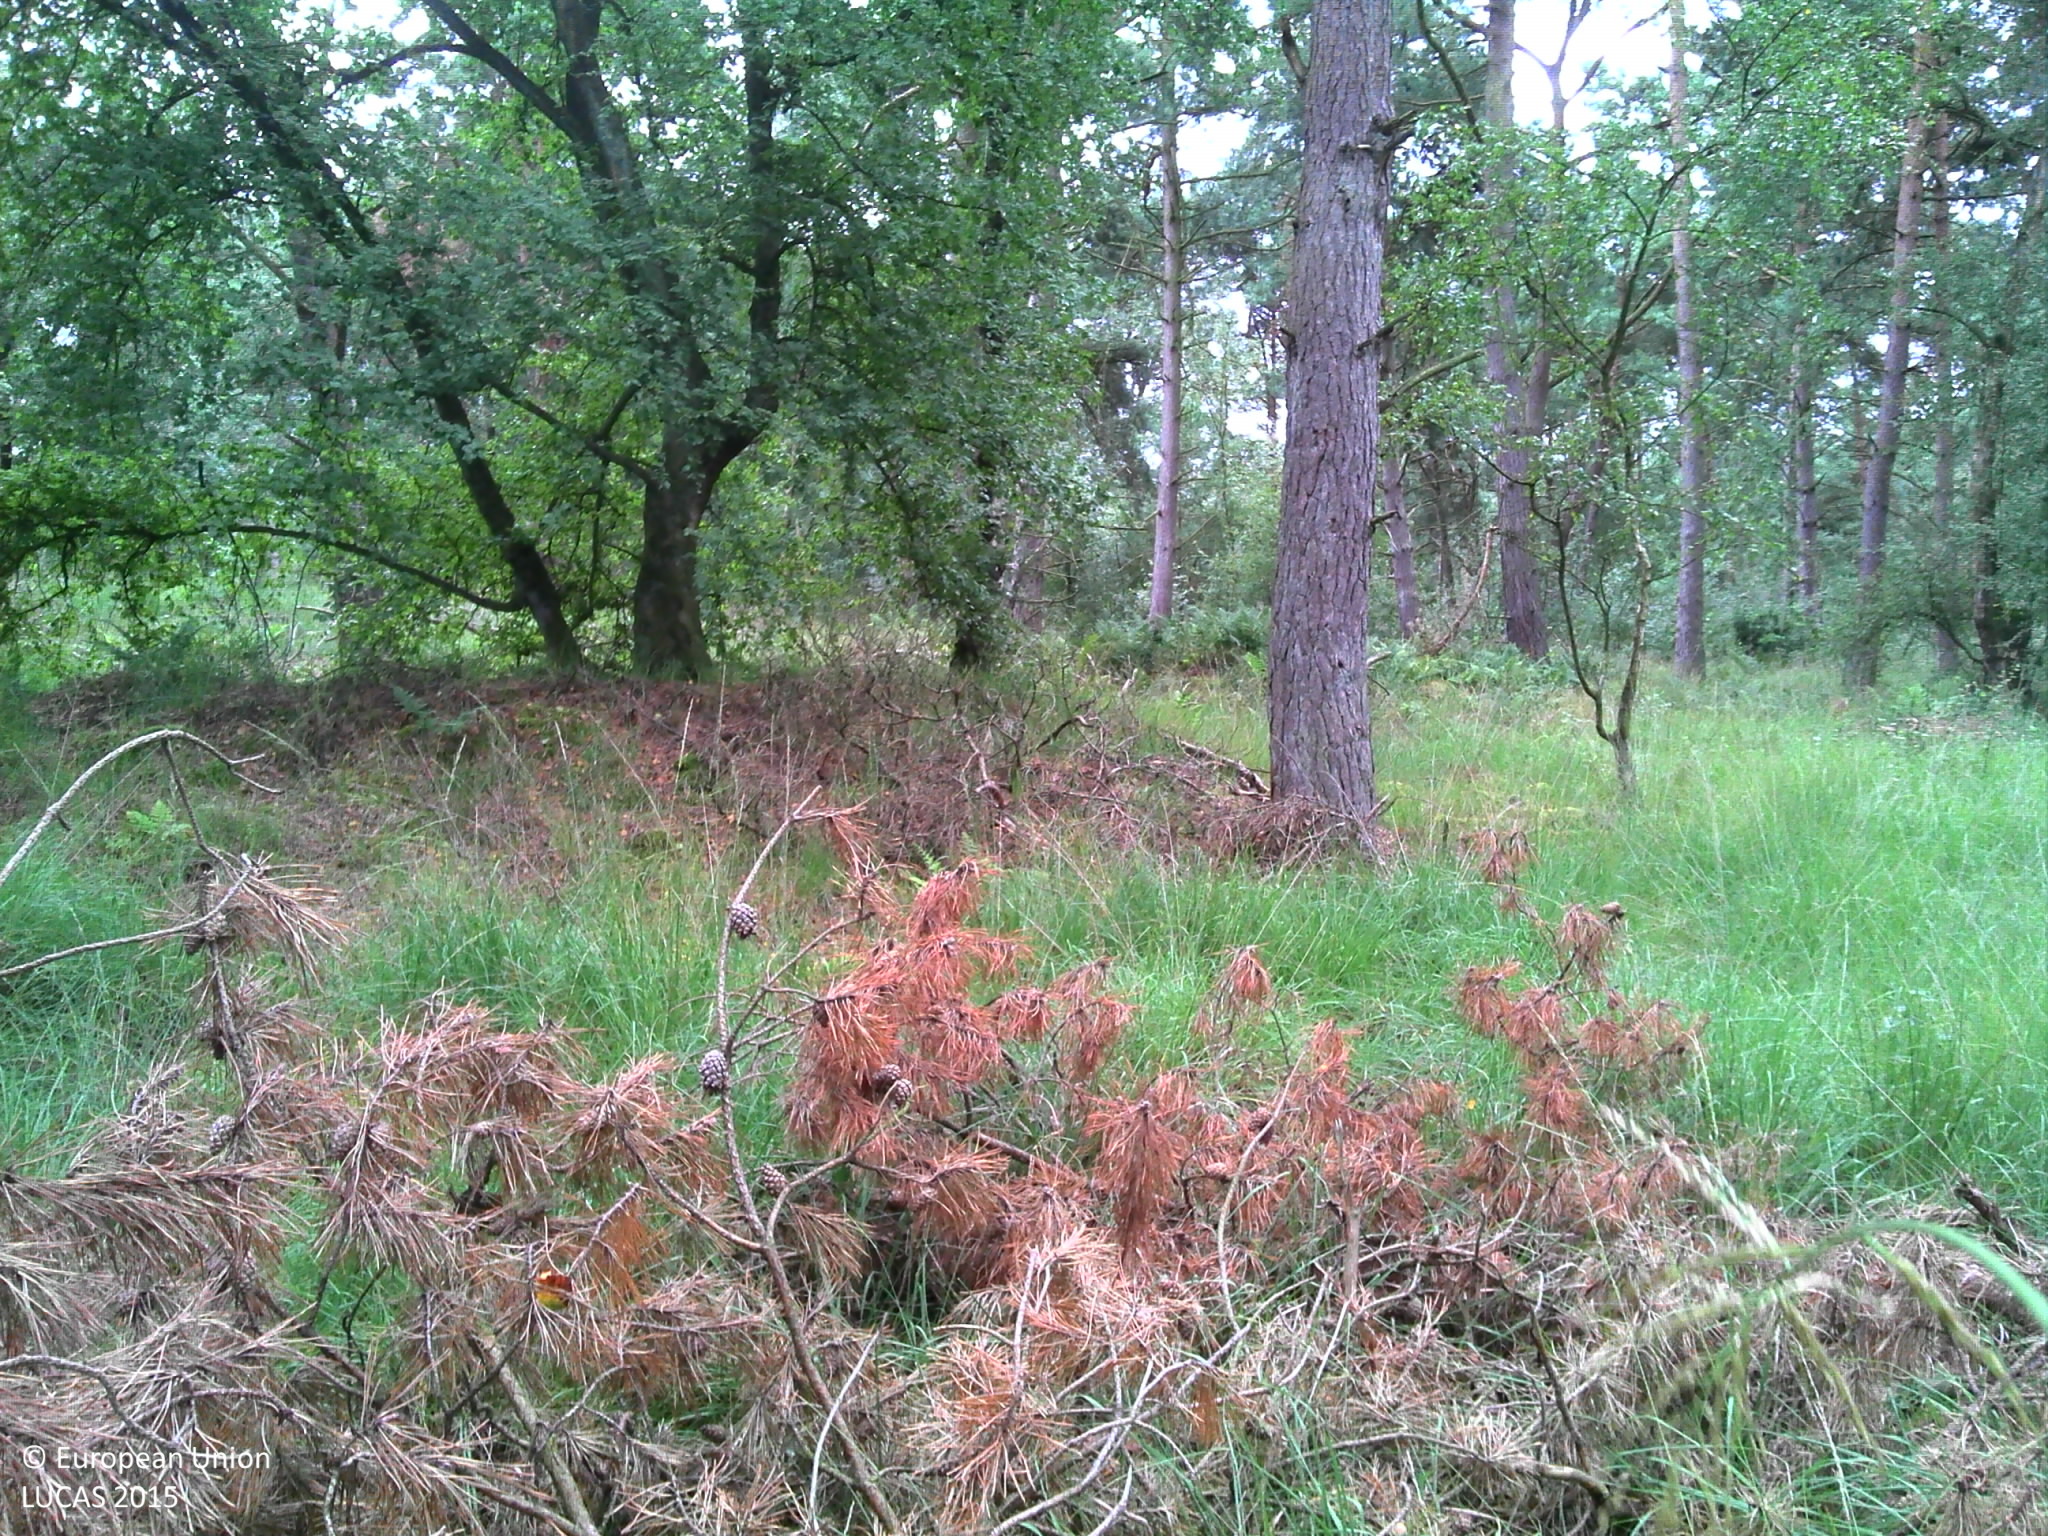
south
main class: Woodland
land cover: Pine dominated mixed woodland
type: acidophilous oak and oak-birch forest
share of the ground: > 75 %
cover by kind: coniferous forest trees 40 %, broadleaved forest trees 35 %, herbaceous plants 25 %
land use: Community services
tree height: > 5 m
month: September
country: BE
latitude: 51.3490
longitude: 4.4967
